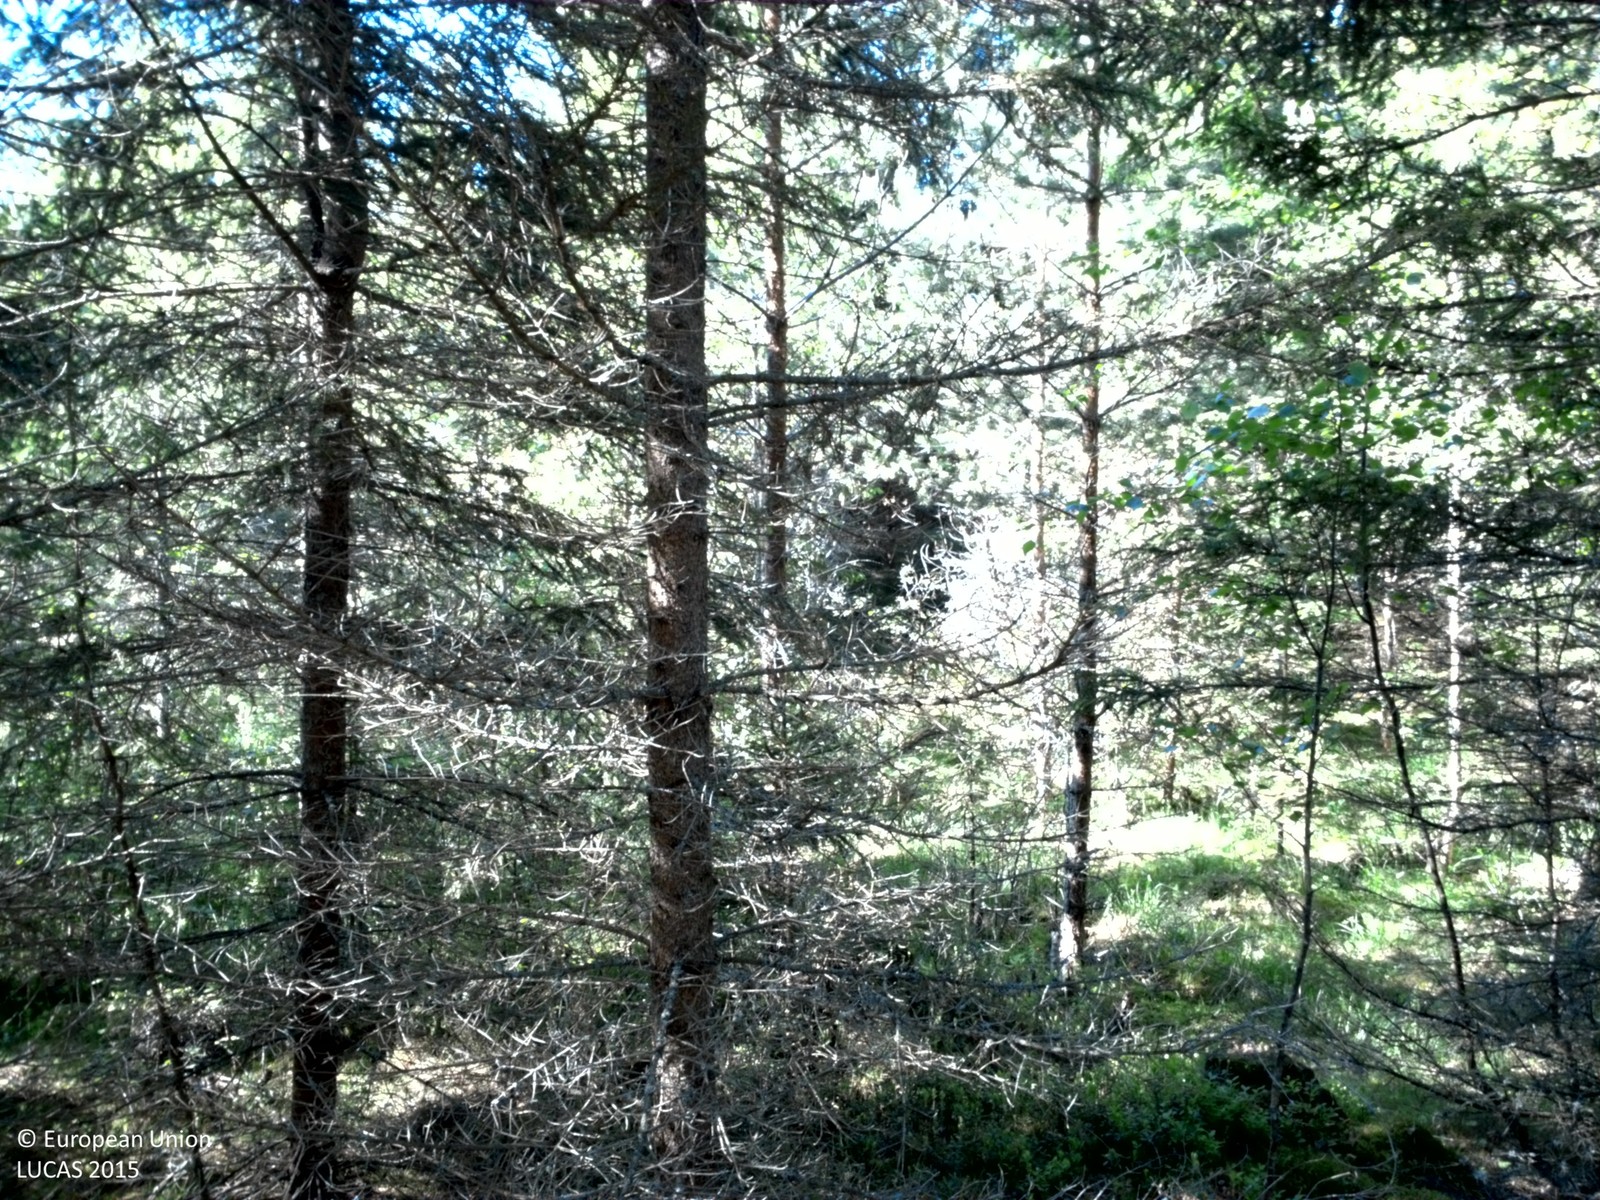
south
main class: Woodland
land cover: Spruce dominated mixed woodland
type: boreal forest
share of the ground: > 75 %
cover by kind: coniferous forest trees 70 %, broadleaved forest trees 25 %, lichens and mosses 5 %
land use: Forestry
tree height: > 5 m
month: June
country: SE
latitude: 58.7018
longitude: 14.5320
